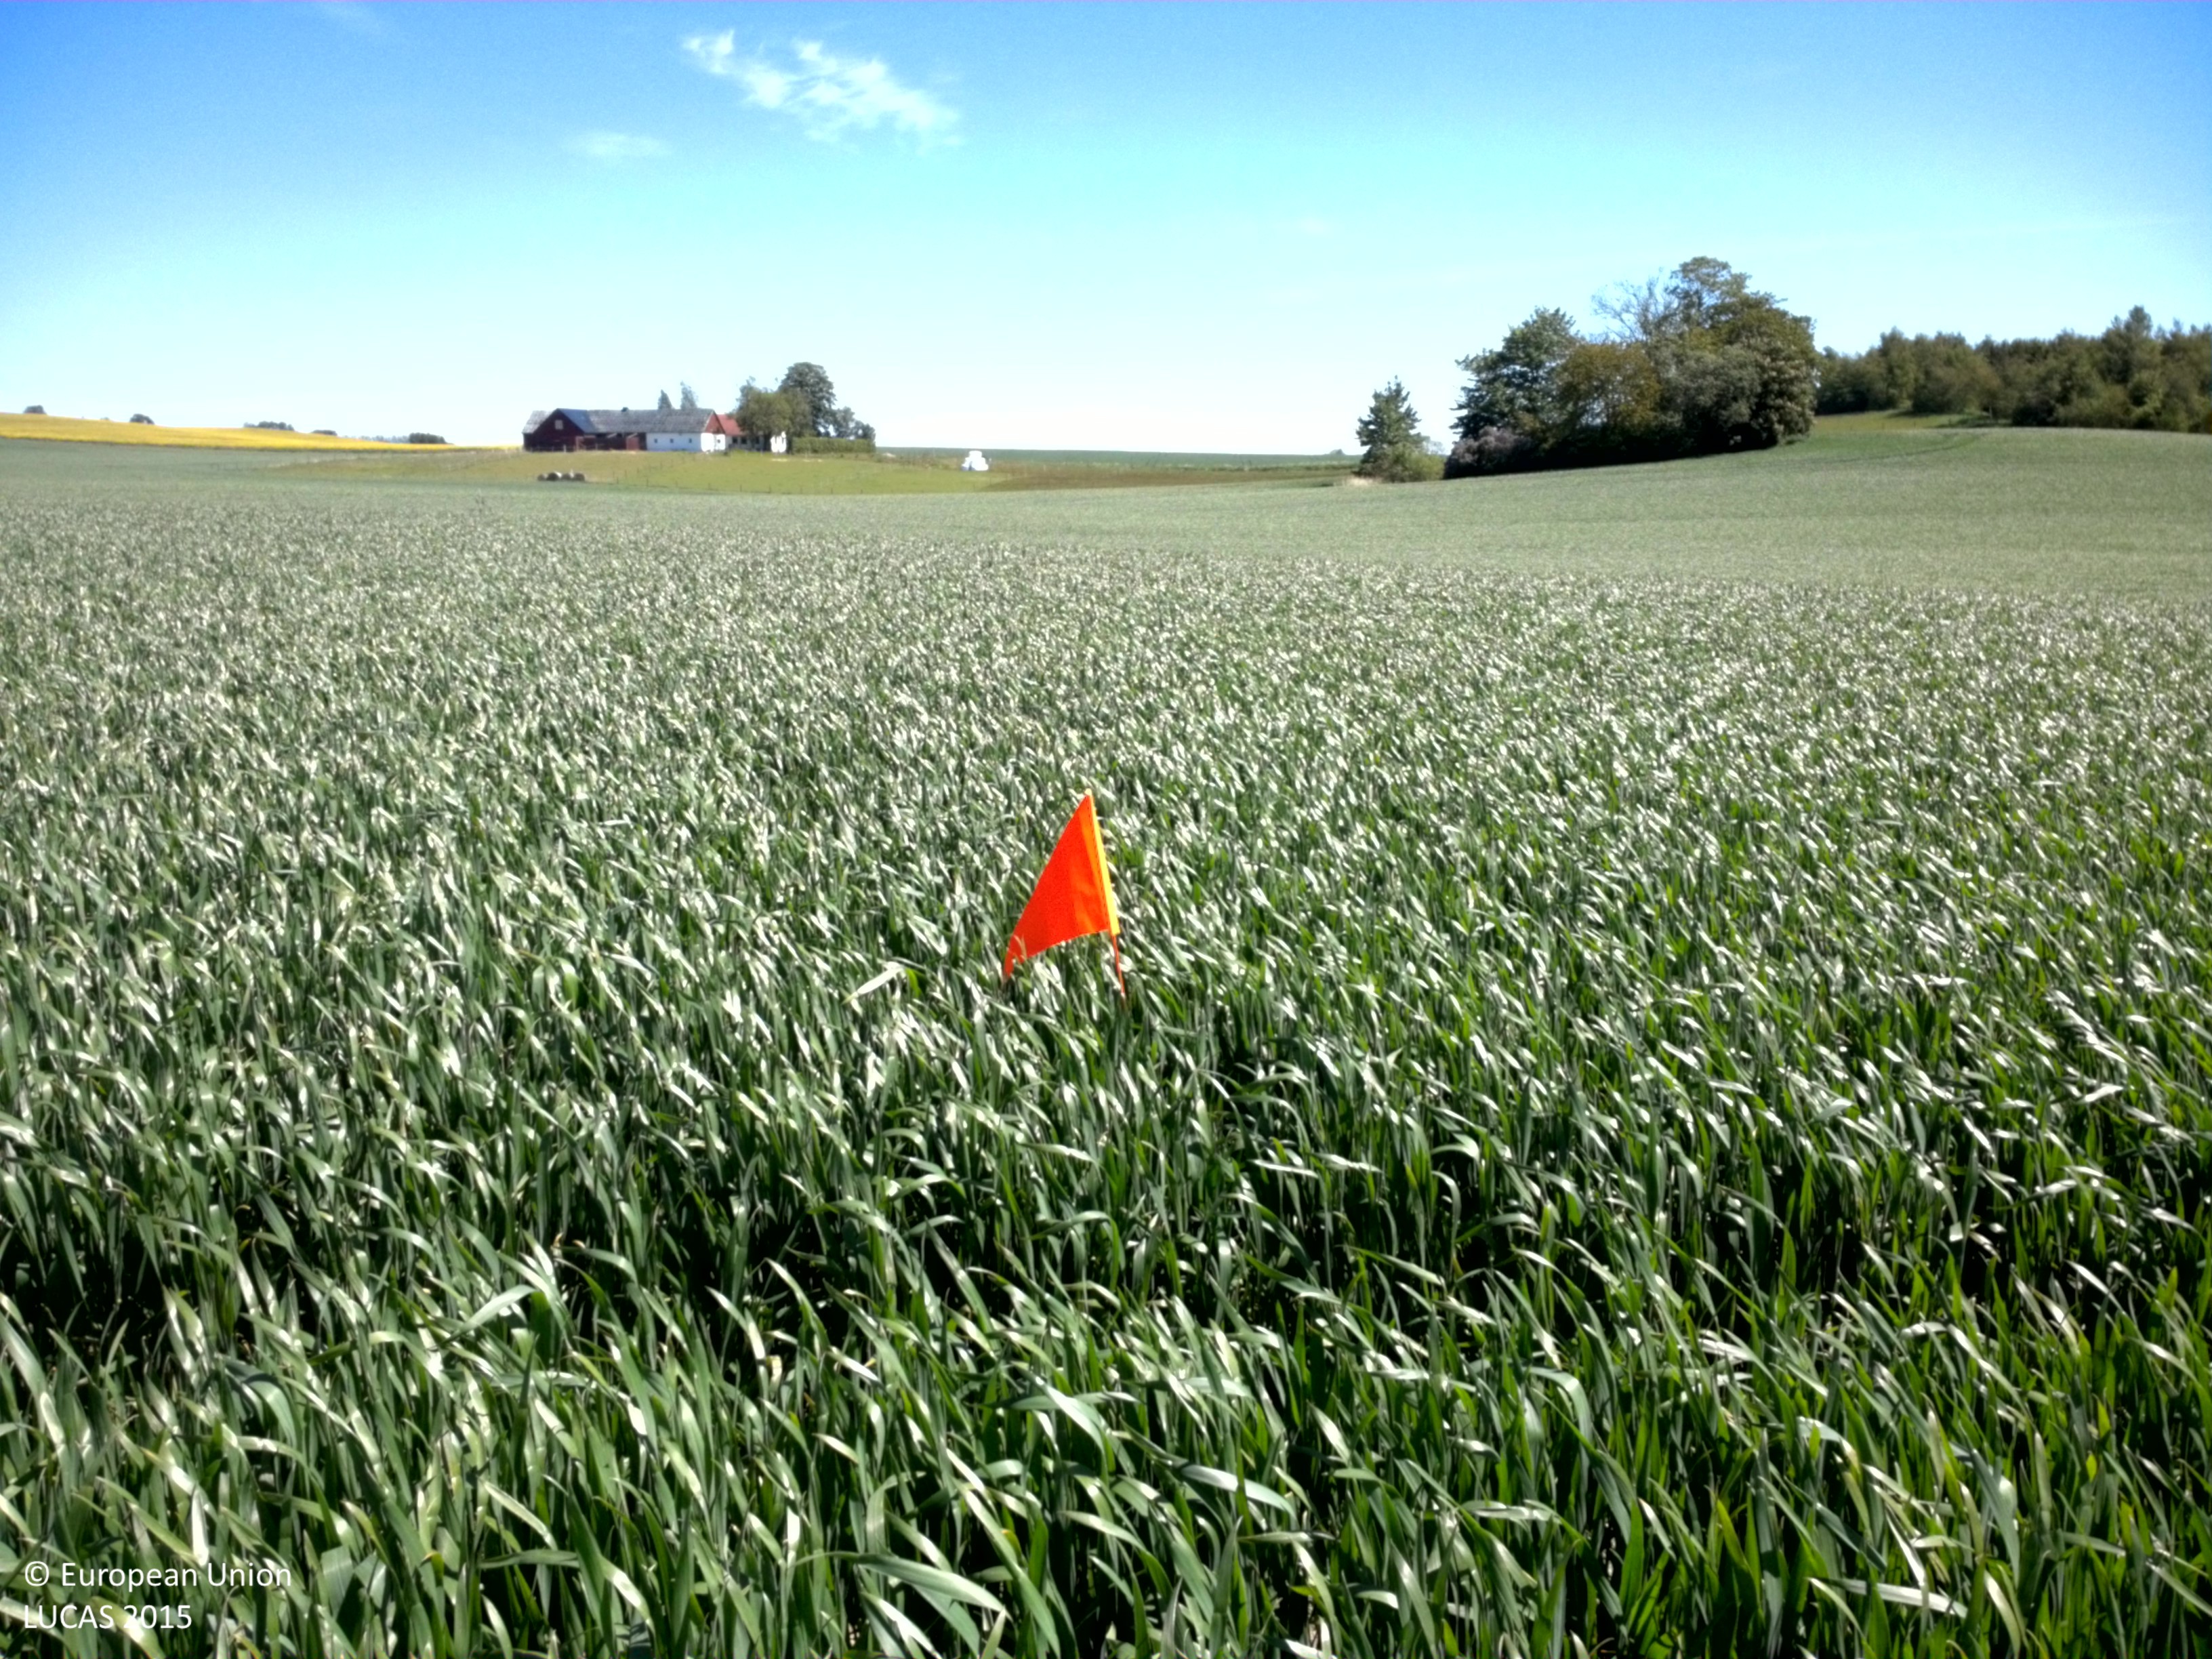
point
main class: Cropland
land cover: Common wheat
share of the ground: > 75 %
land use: Agriculture (excluding fallow land and kitchen gardens)
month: June
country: SE
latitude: 55.4871
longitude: 13.6857
